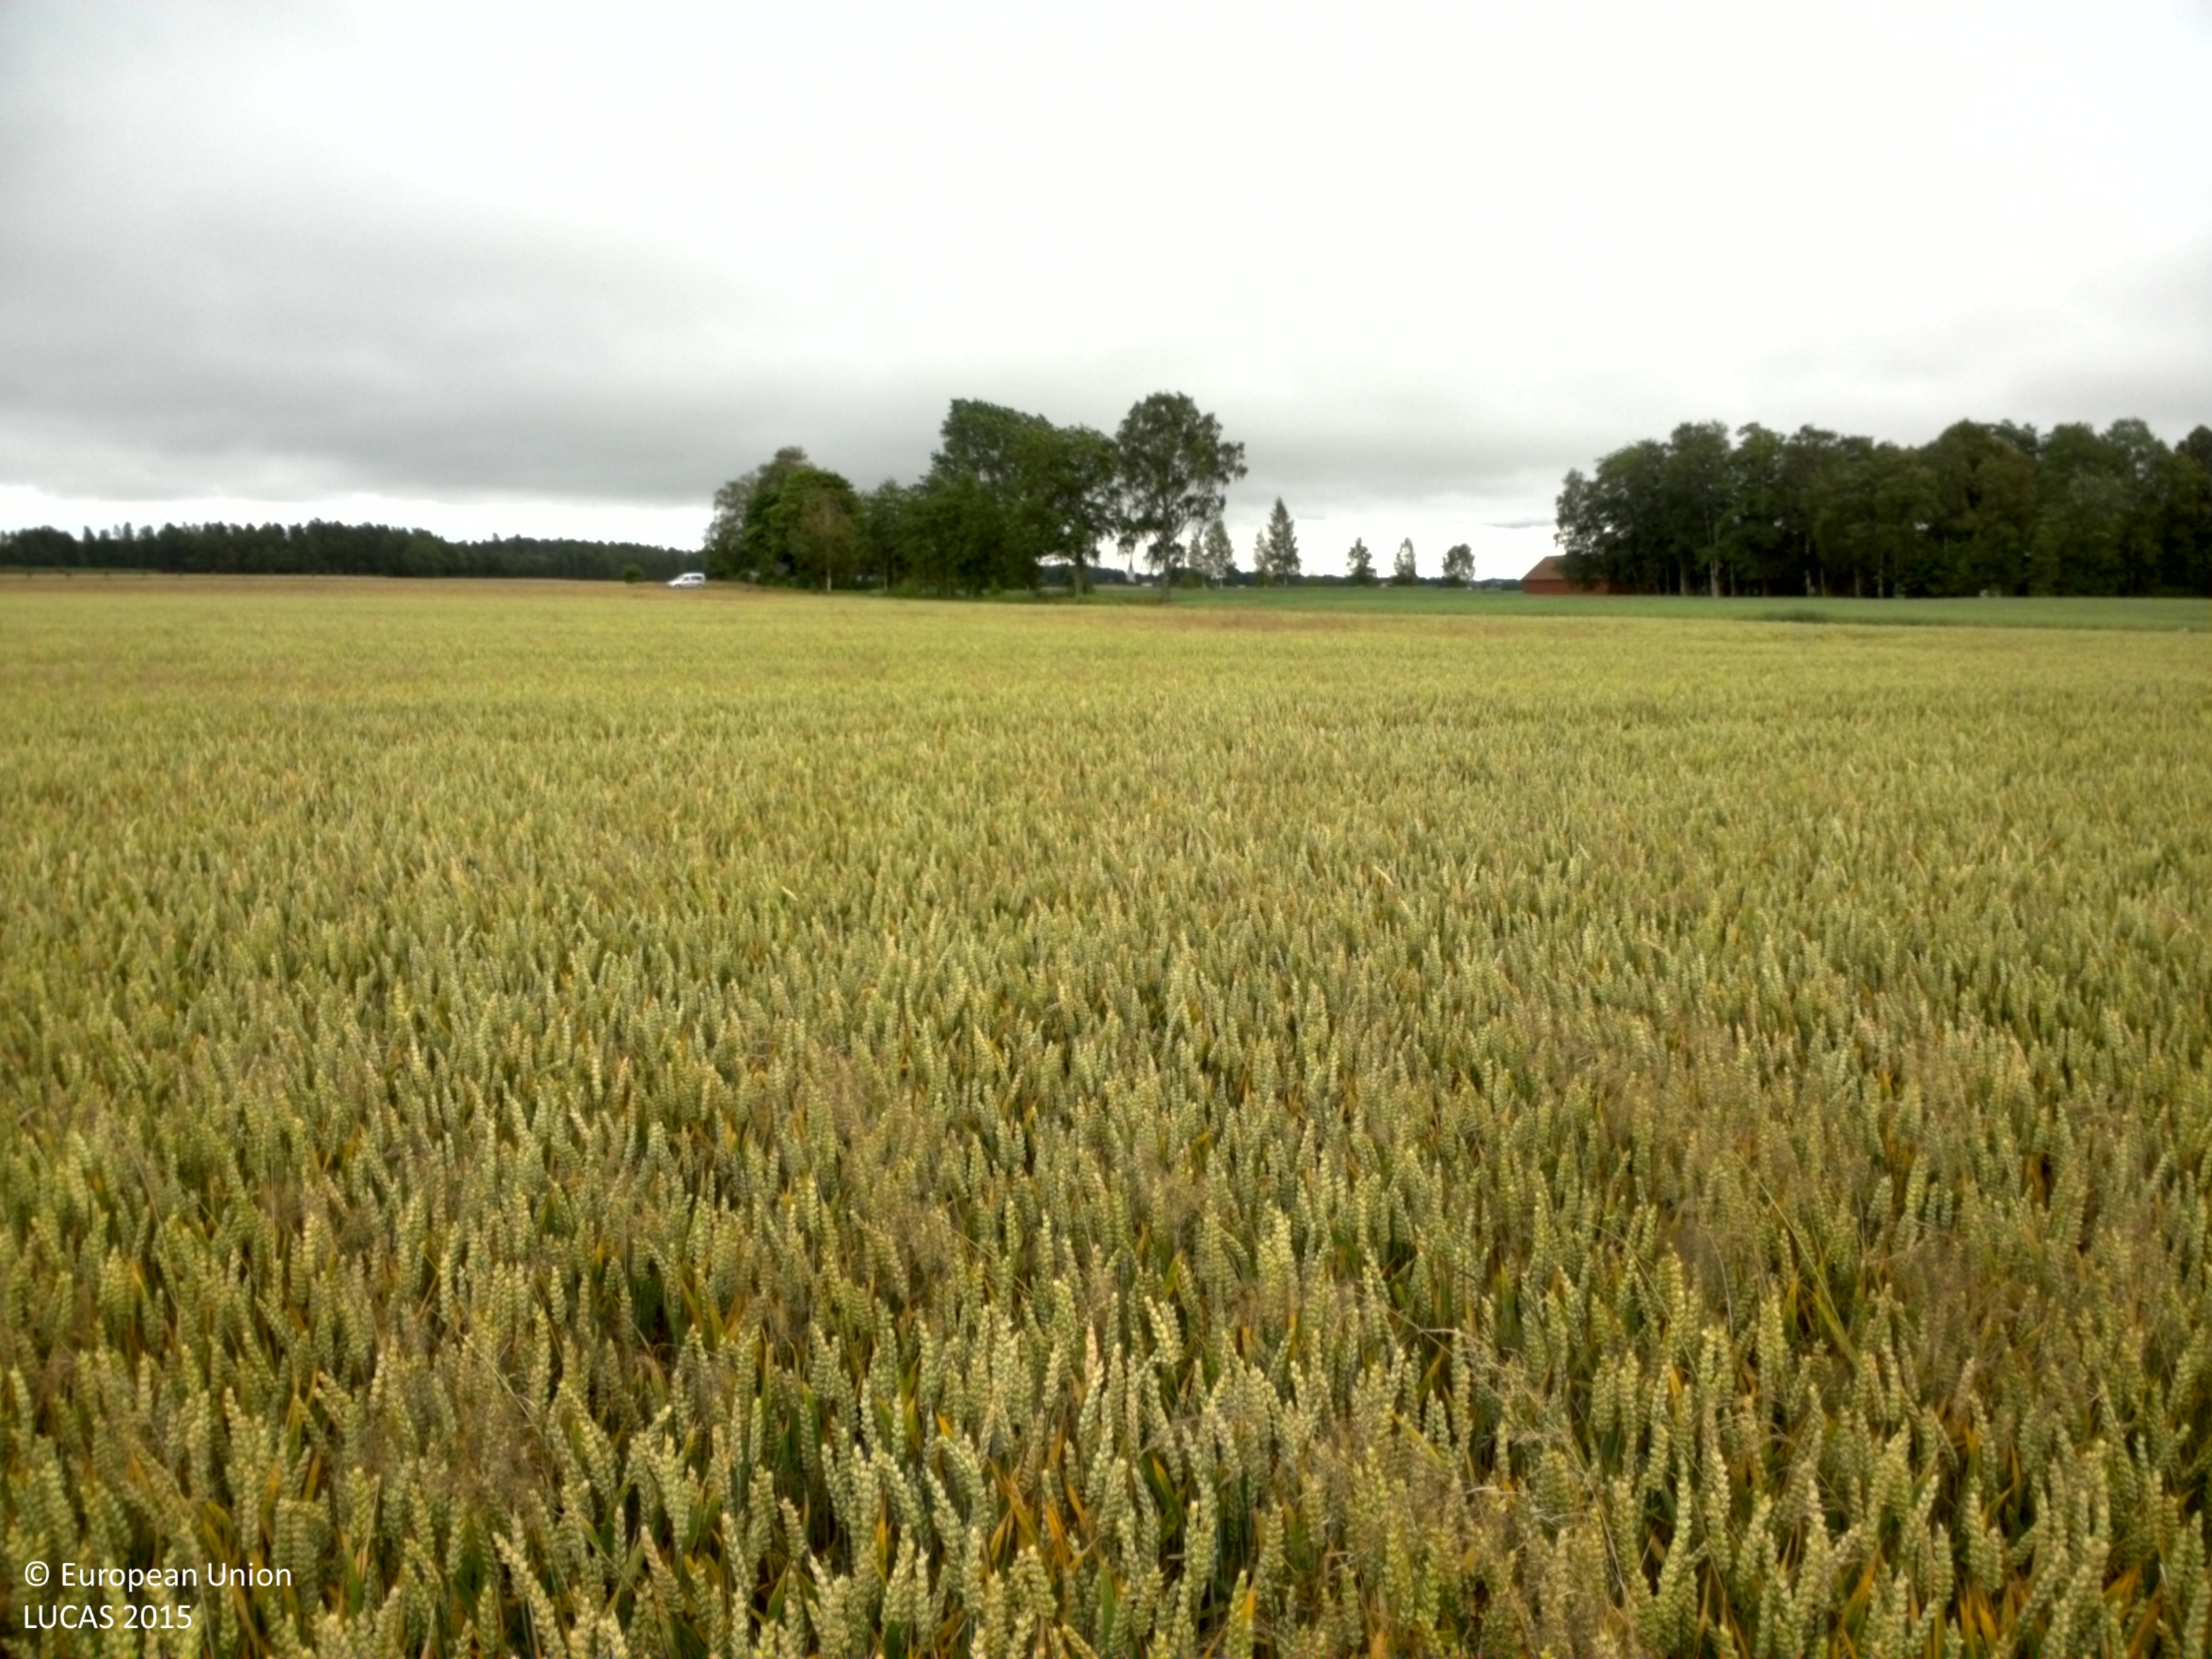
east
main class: Cropland
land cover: Barley
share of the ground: > 75 %
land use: Agriculture (excluding fallow land and kitchen gardens)
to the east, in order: Barley; Ditches and canals; Grass margins; Common wheat; Shruby margins; Ditches and canals; Shruby margins; Ditches and canals; Abandoned hedges; Grass margins; Oats
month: July
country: SE
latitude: 58.4327
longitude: 13.2311
